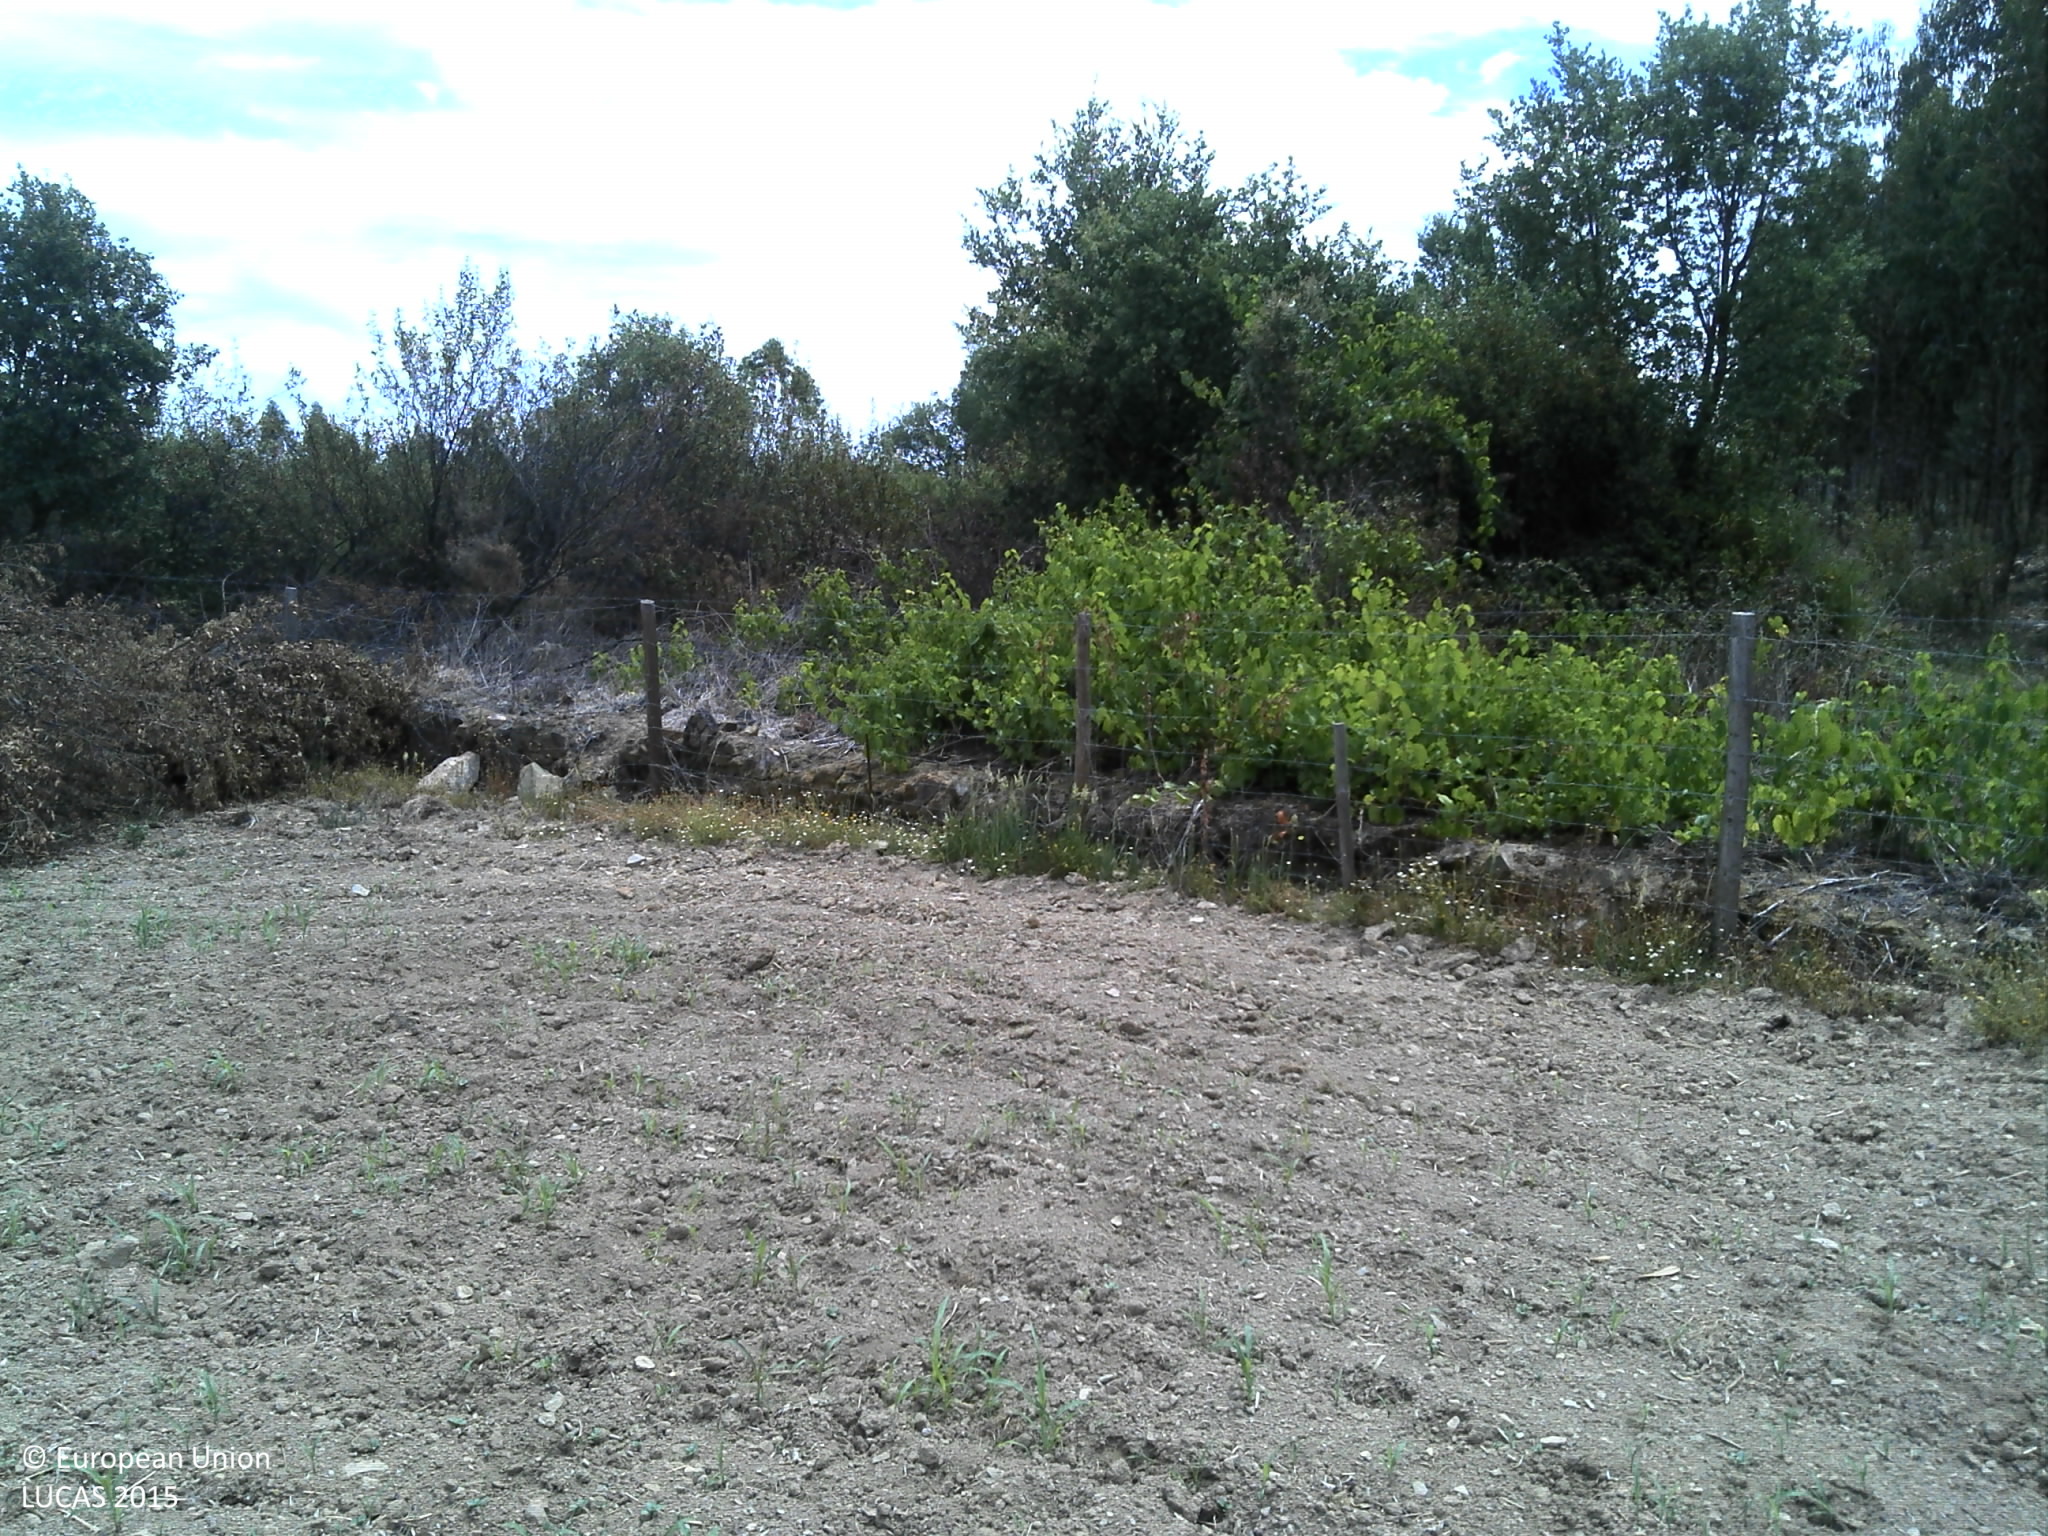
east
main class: Cropland
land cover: Durum wheat
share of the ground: < 10 %
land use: Agriculture (excluding fallow land and kitchen gardens)
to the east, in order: Durum wheat; Fences; Dry stone walls; Shrubland with sparse tree cover; Broadleaved woodland; Olive groves; Shrubland with sparse tree cover; Shrubland without tree cover; Tracks; Shrubland with sparse tree cover; Tracks; Shrubland with sparse tree cover; Pine dominated mixed woodland; Broadleaved woodland; Shrubland with sparse tree cover
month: July
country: PT
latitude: 39.6726
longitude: -8.1236
